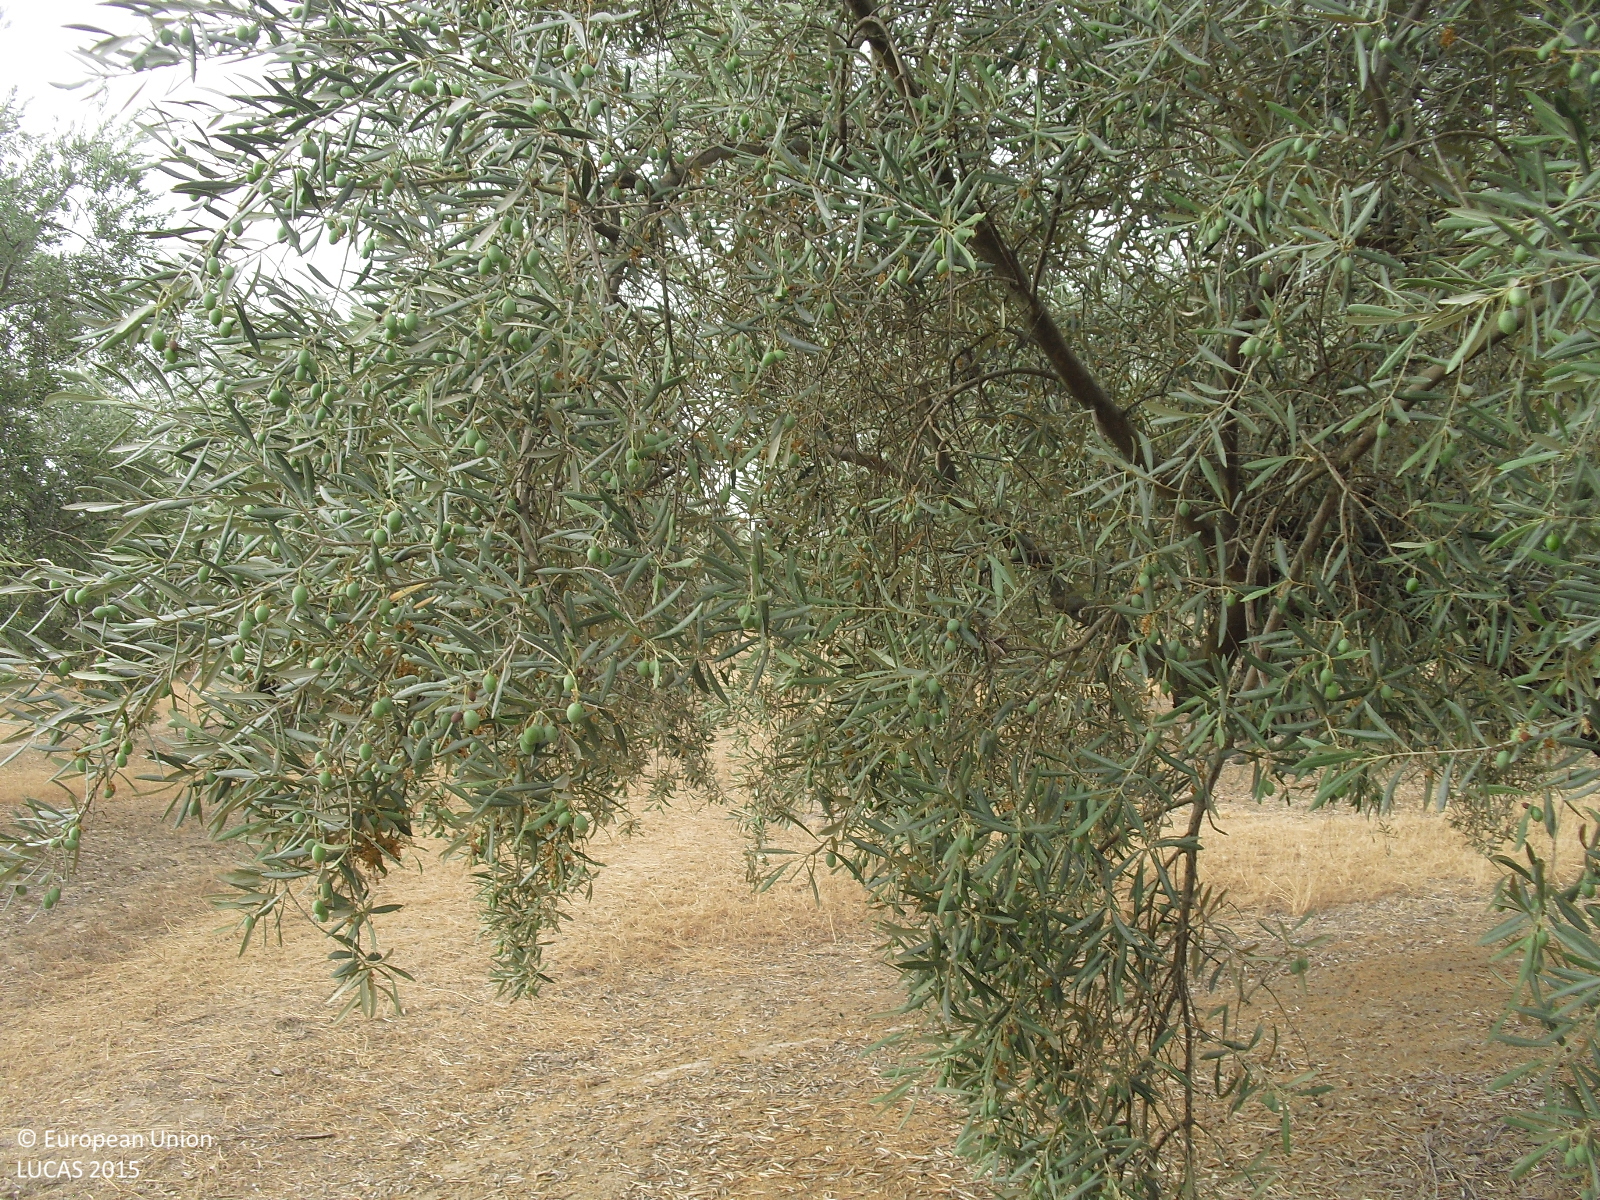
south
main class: Cropland
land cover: Olive groves
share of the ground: 25 - 50 %
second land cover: Spontaneously vegetated surfaces
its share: 25 - 50 %
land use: Agriculture (excluding fallow land and kitchen gardens)
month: August
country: ES
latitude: 37.1894
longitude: -4.0869
